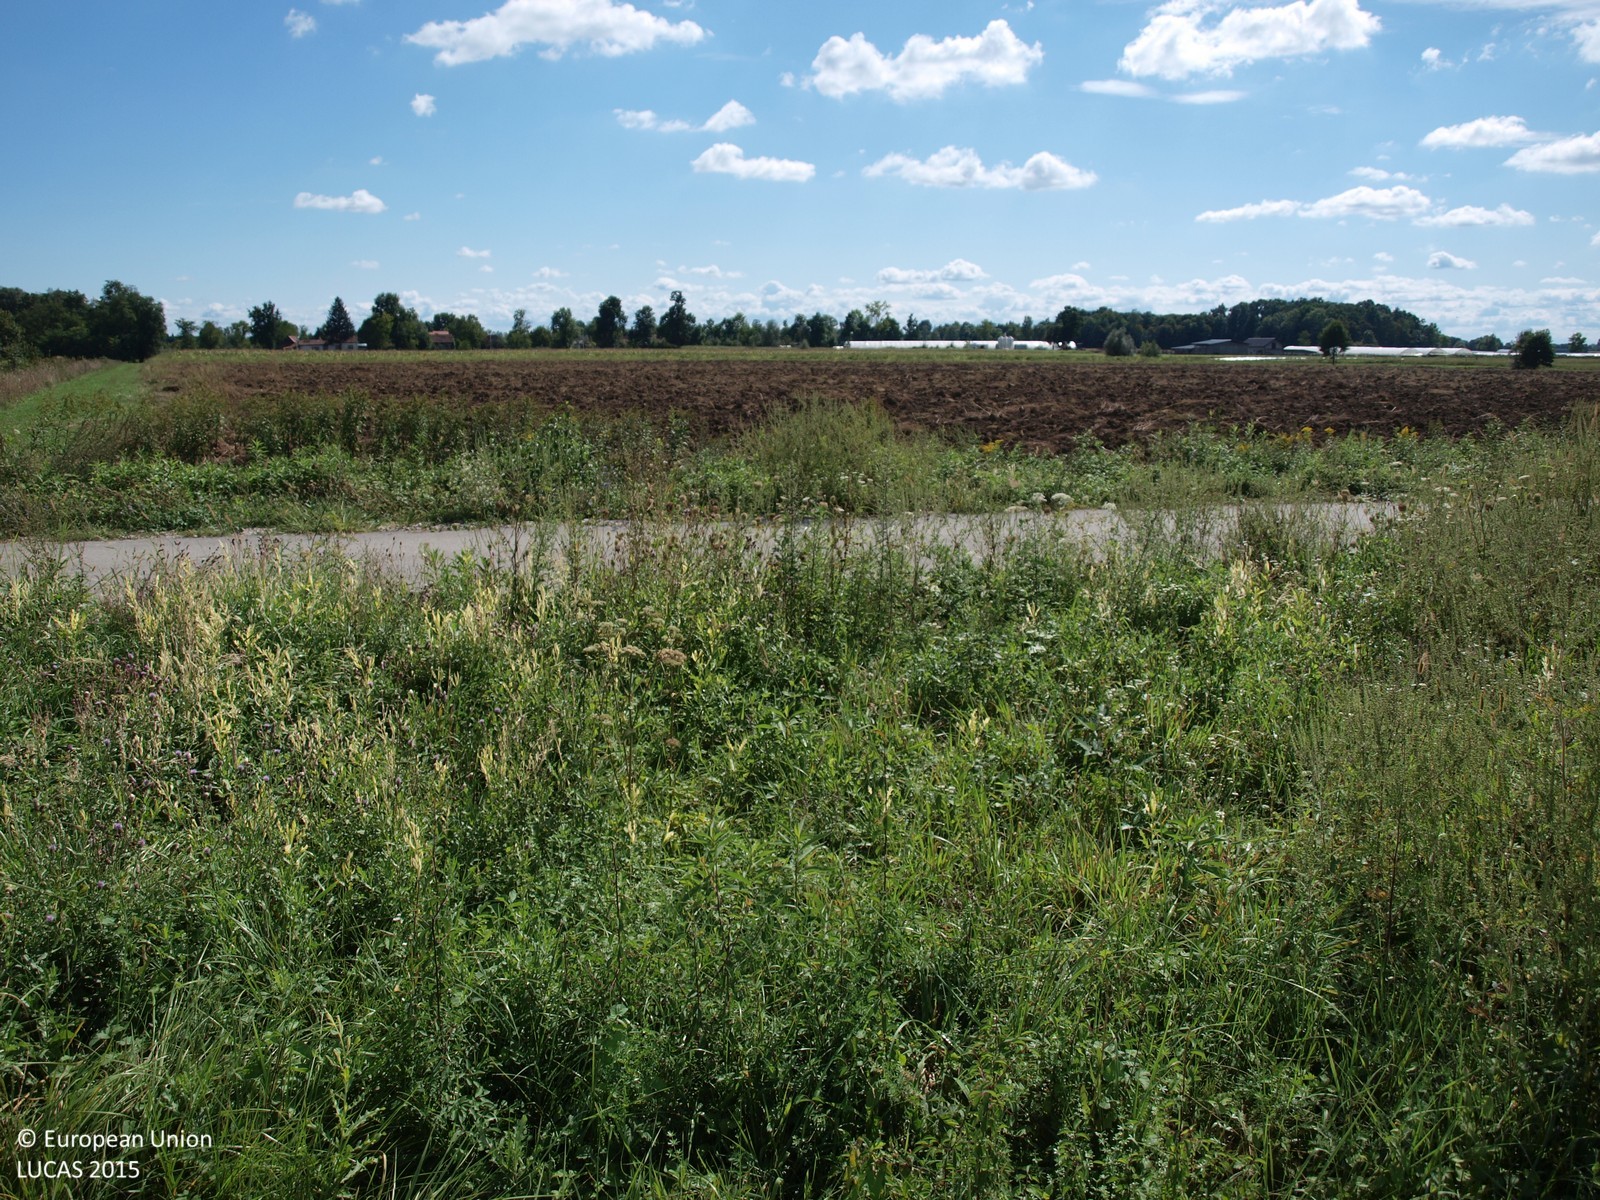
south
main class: Grassland
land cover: Grassland without tree/shrub cover
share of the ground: > 75 %
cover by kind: herbaceous plants 100 %
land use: Semi-natural and natural areas not in use
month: September
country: HR
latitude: 45.7283
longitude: 16.3591
